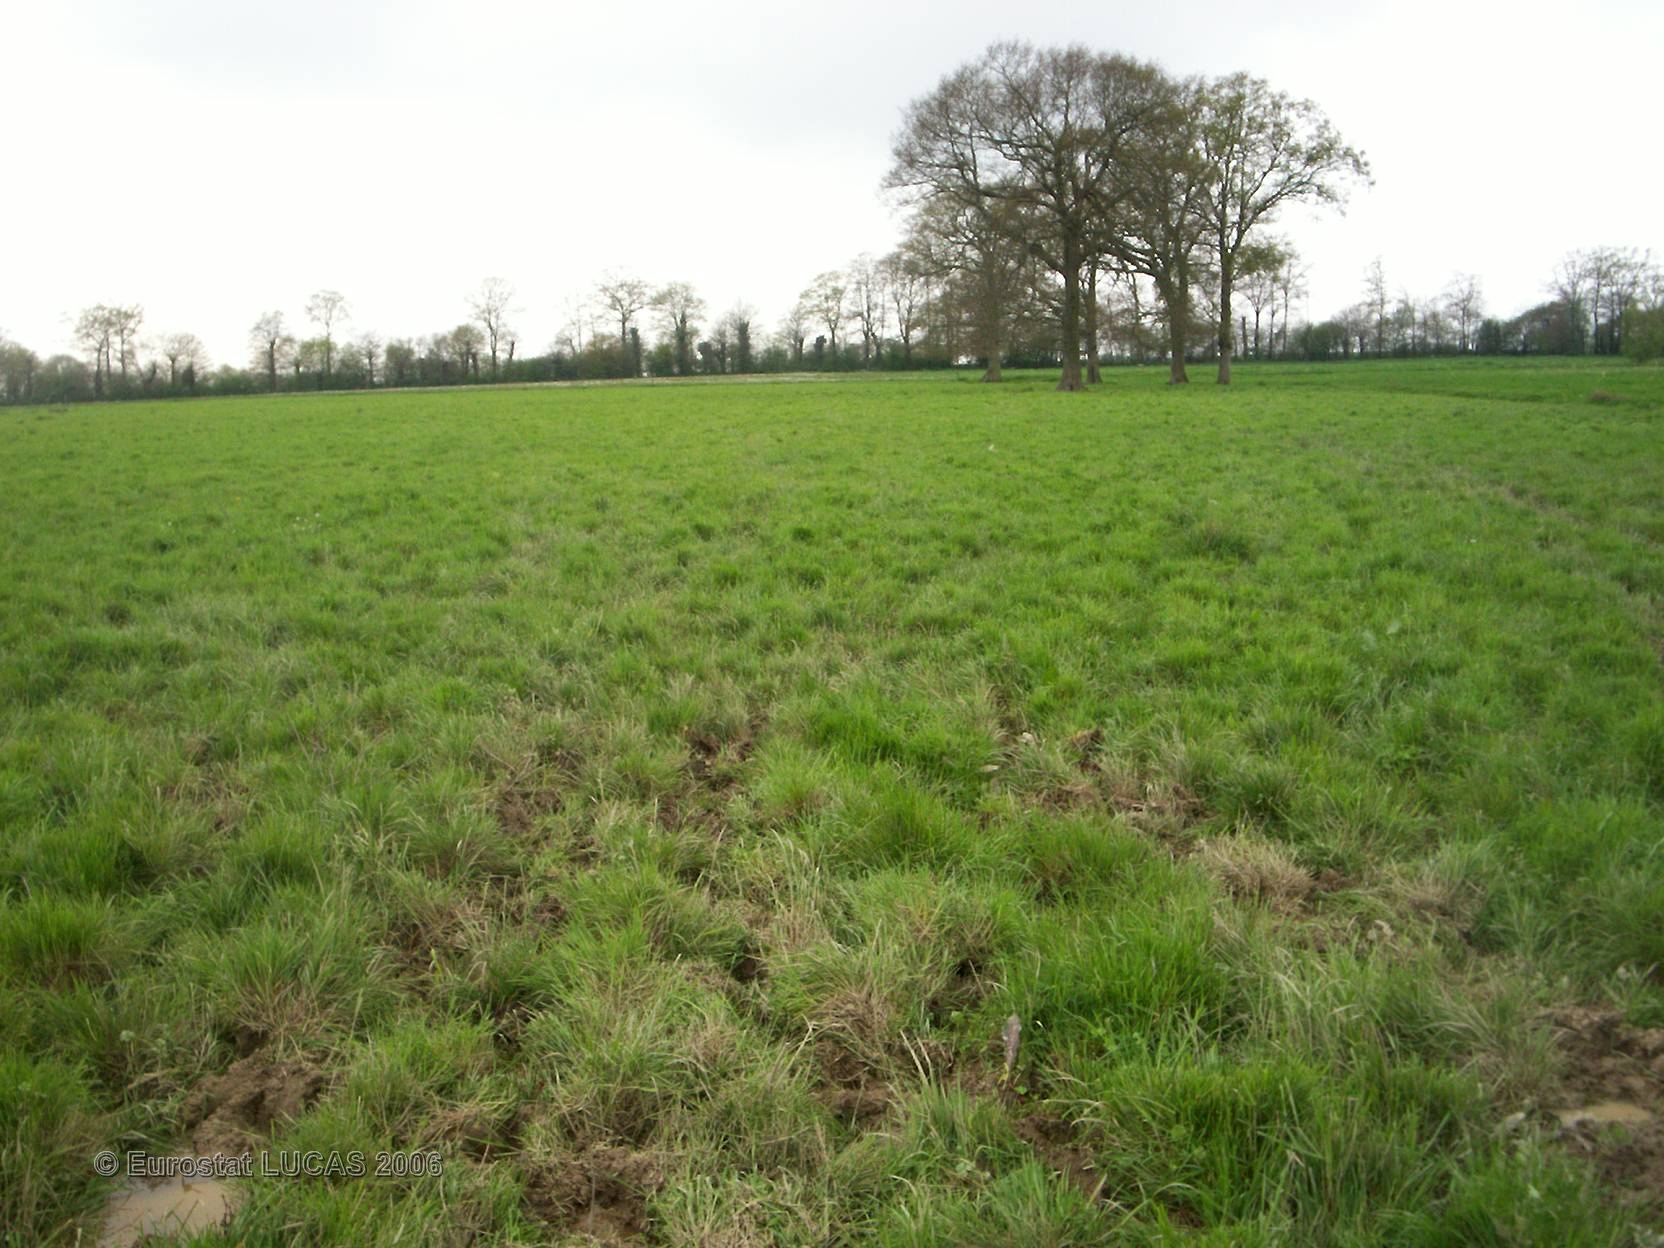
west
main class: Grassland
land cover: Grassland without tree/shrub cover
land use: Agriculture (excluding fallow land and kitchen gardens)
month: April
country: FR
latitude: 47.9035
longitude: -1.5638
